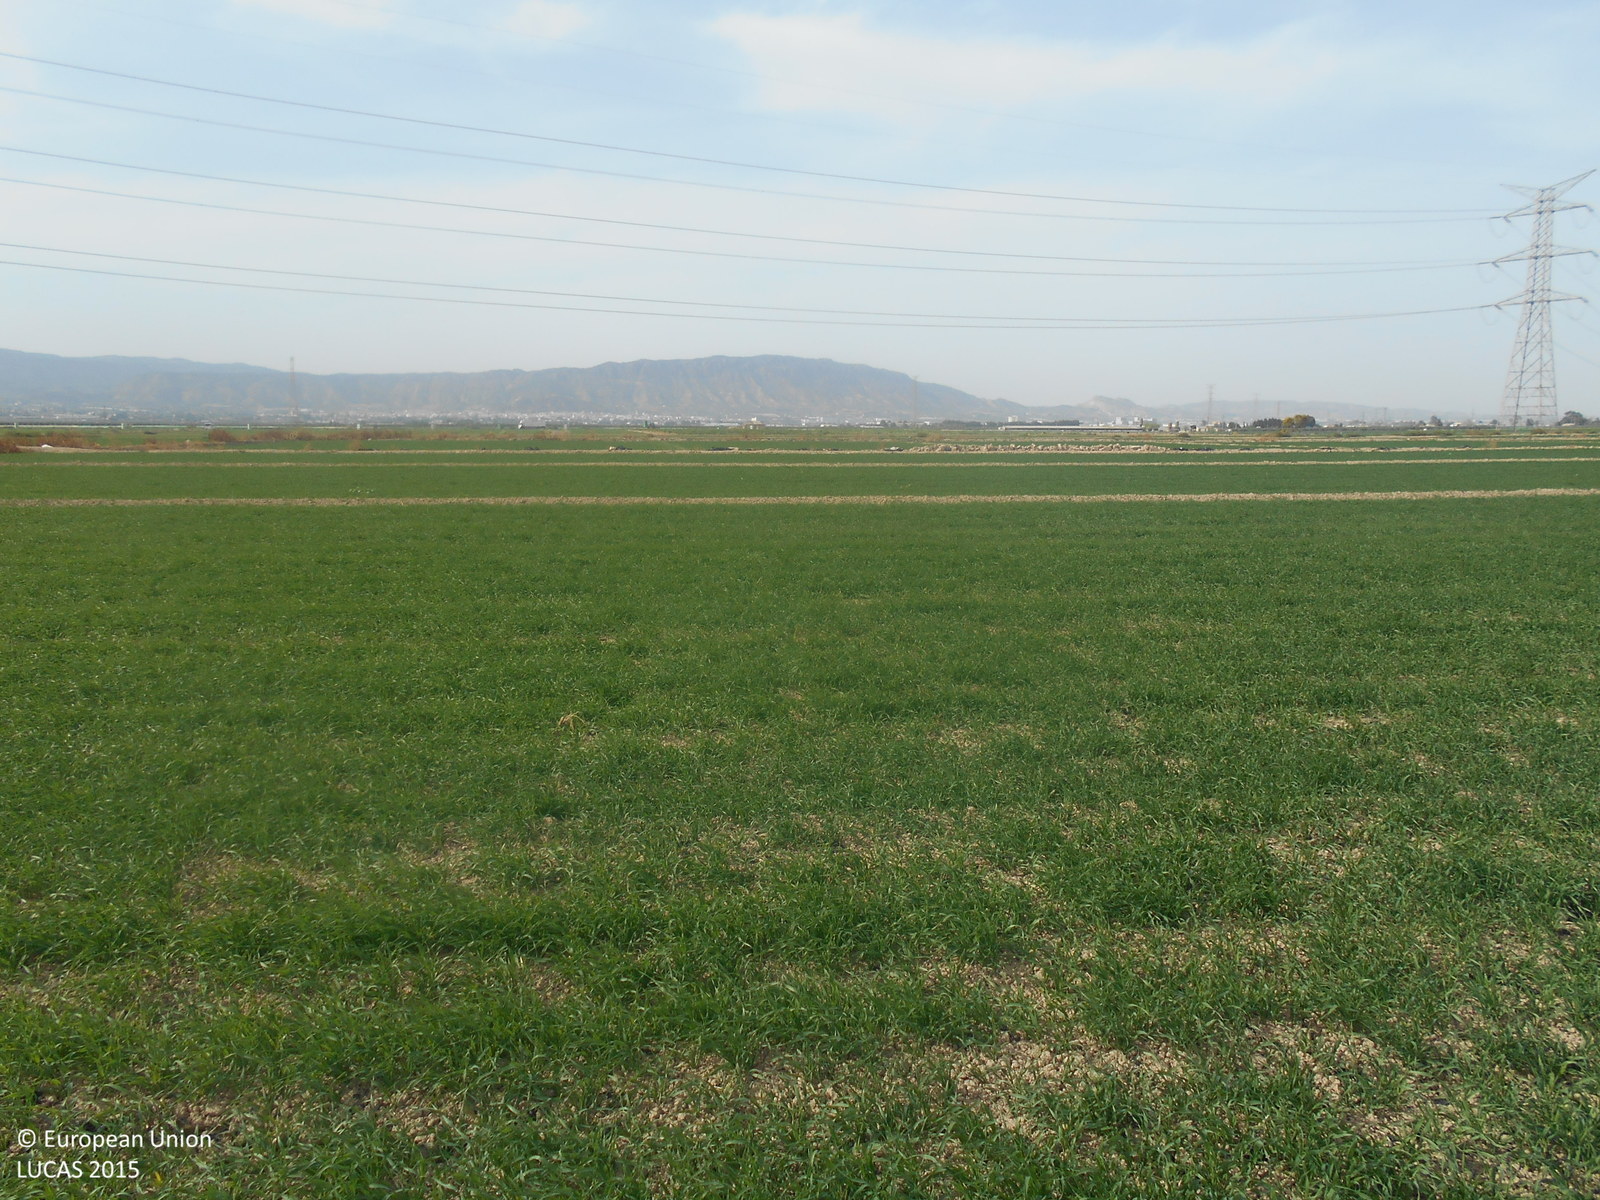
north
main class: Cropland
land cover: Barley
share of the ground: > 75 %
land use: Agriculture (excluding fallow land and kitchen gardens)
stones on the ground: < 10 %
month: April
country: ES
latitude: 37.7920
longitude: -1.3953
